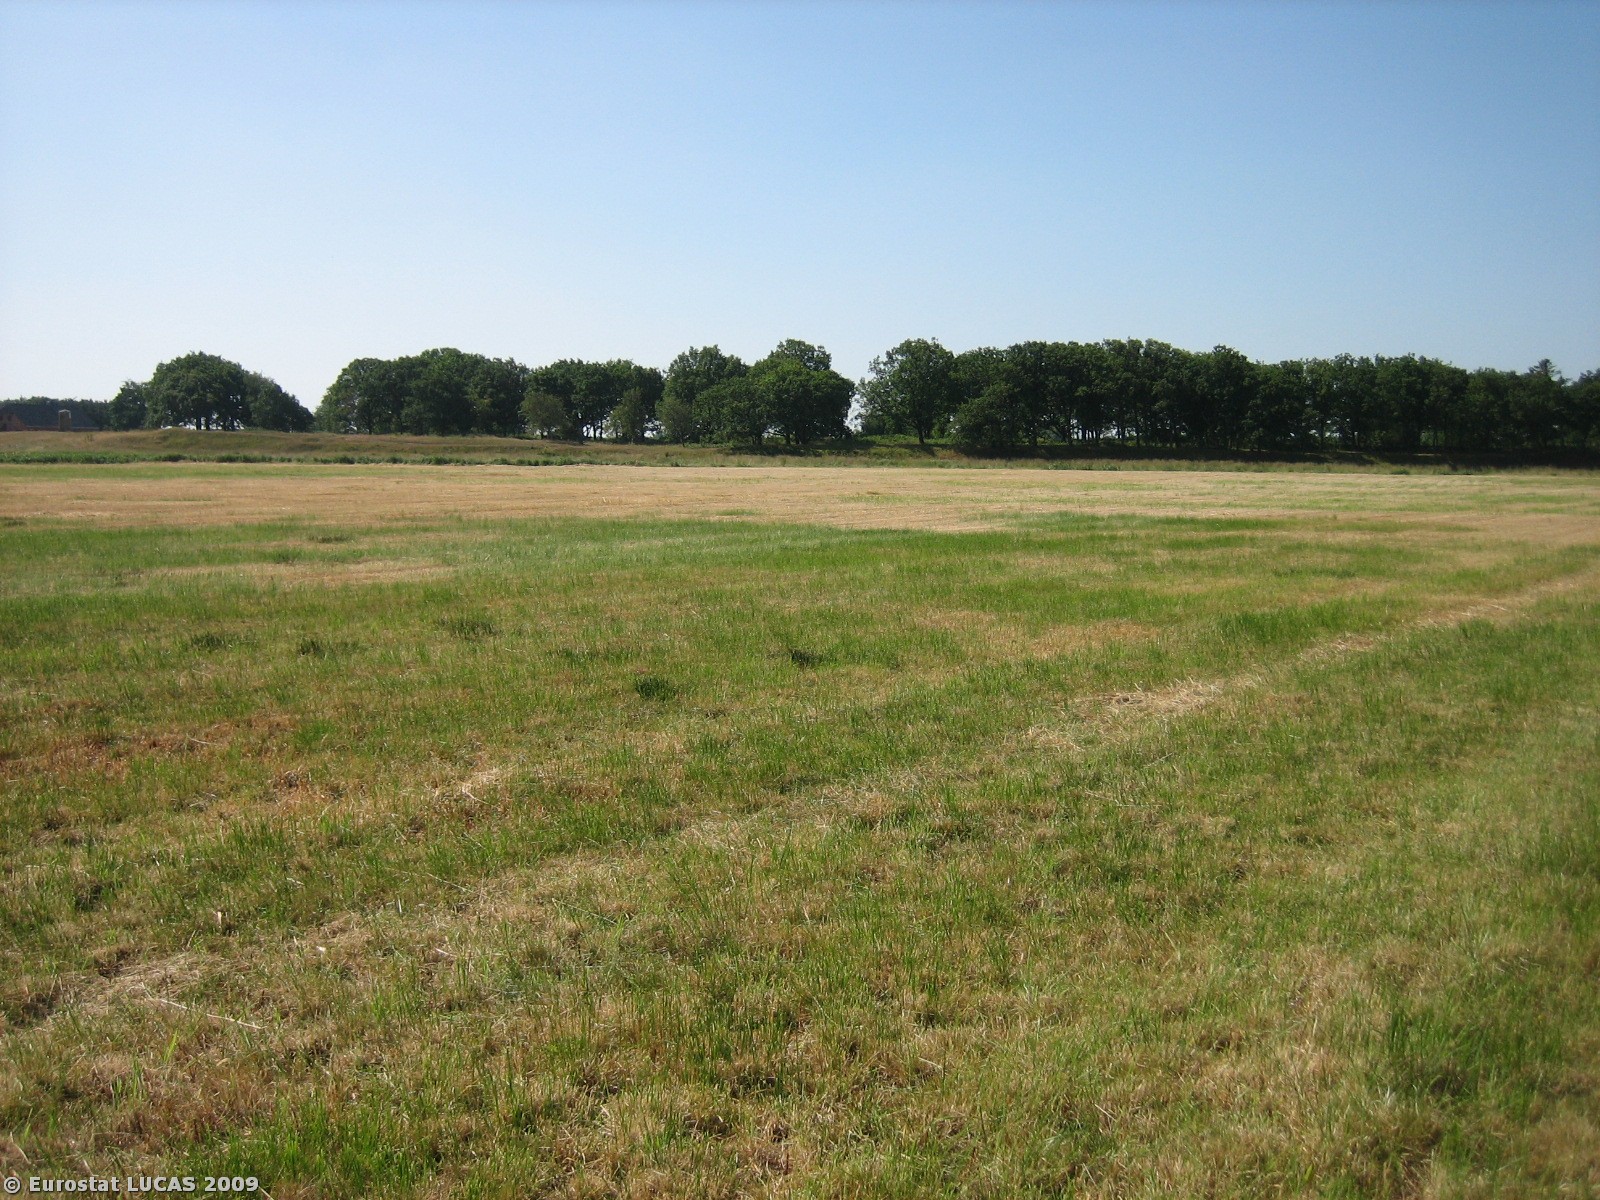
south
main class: Cropland
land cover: Temporary grasslands
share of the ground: > 75 %
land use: Agriculture (excluding fallow land and kitchen gardens)
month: July
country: DK
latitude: 55.4099
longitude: 8.8796
